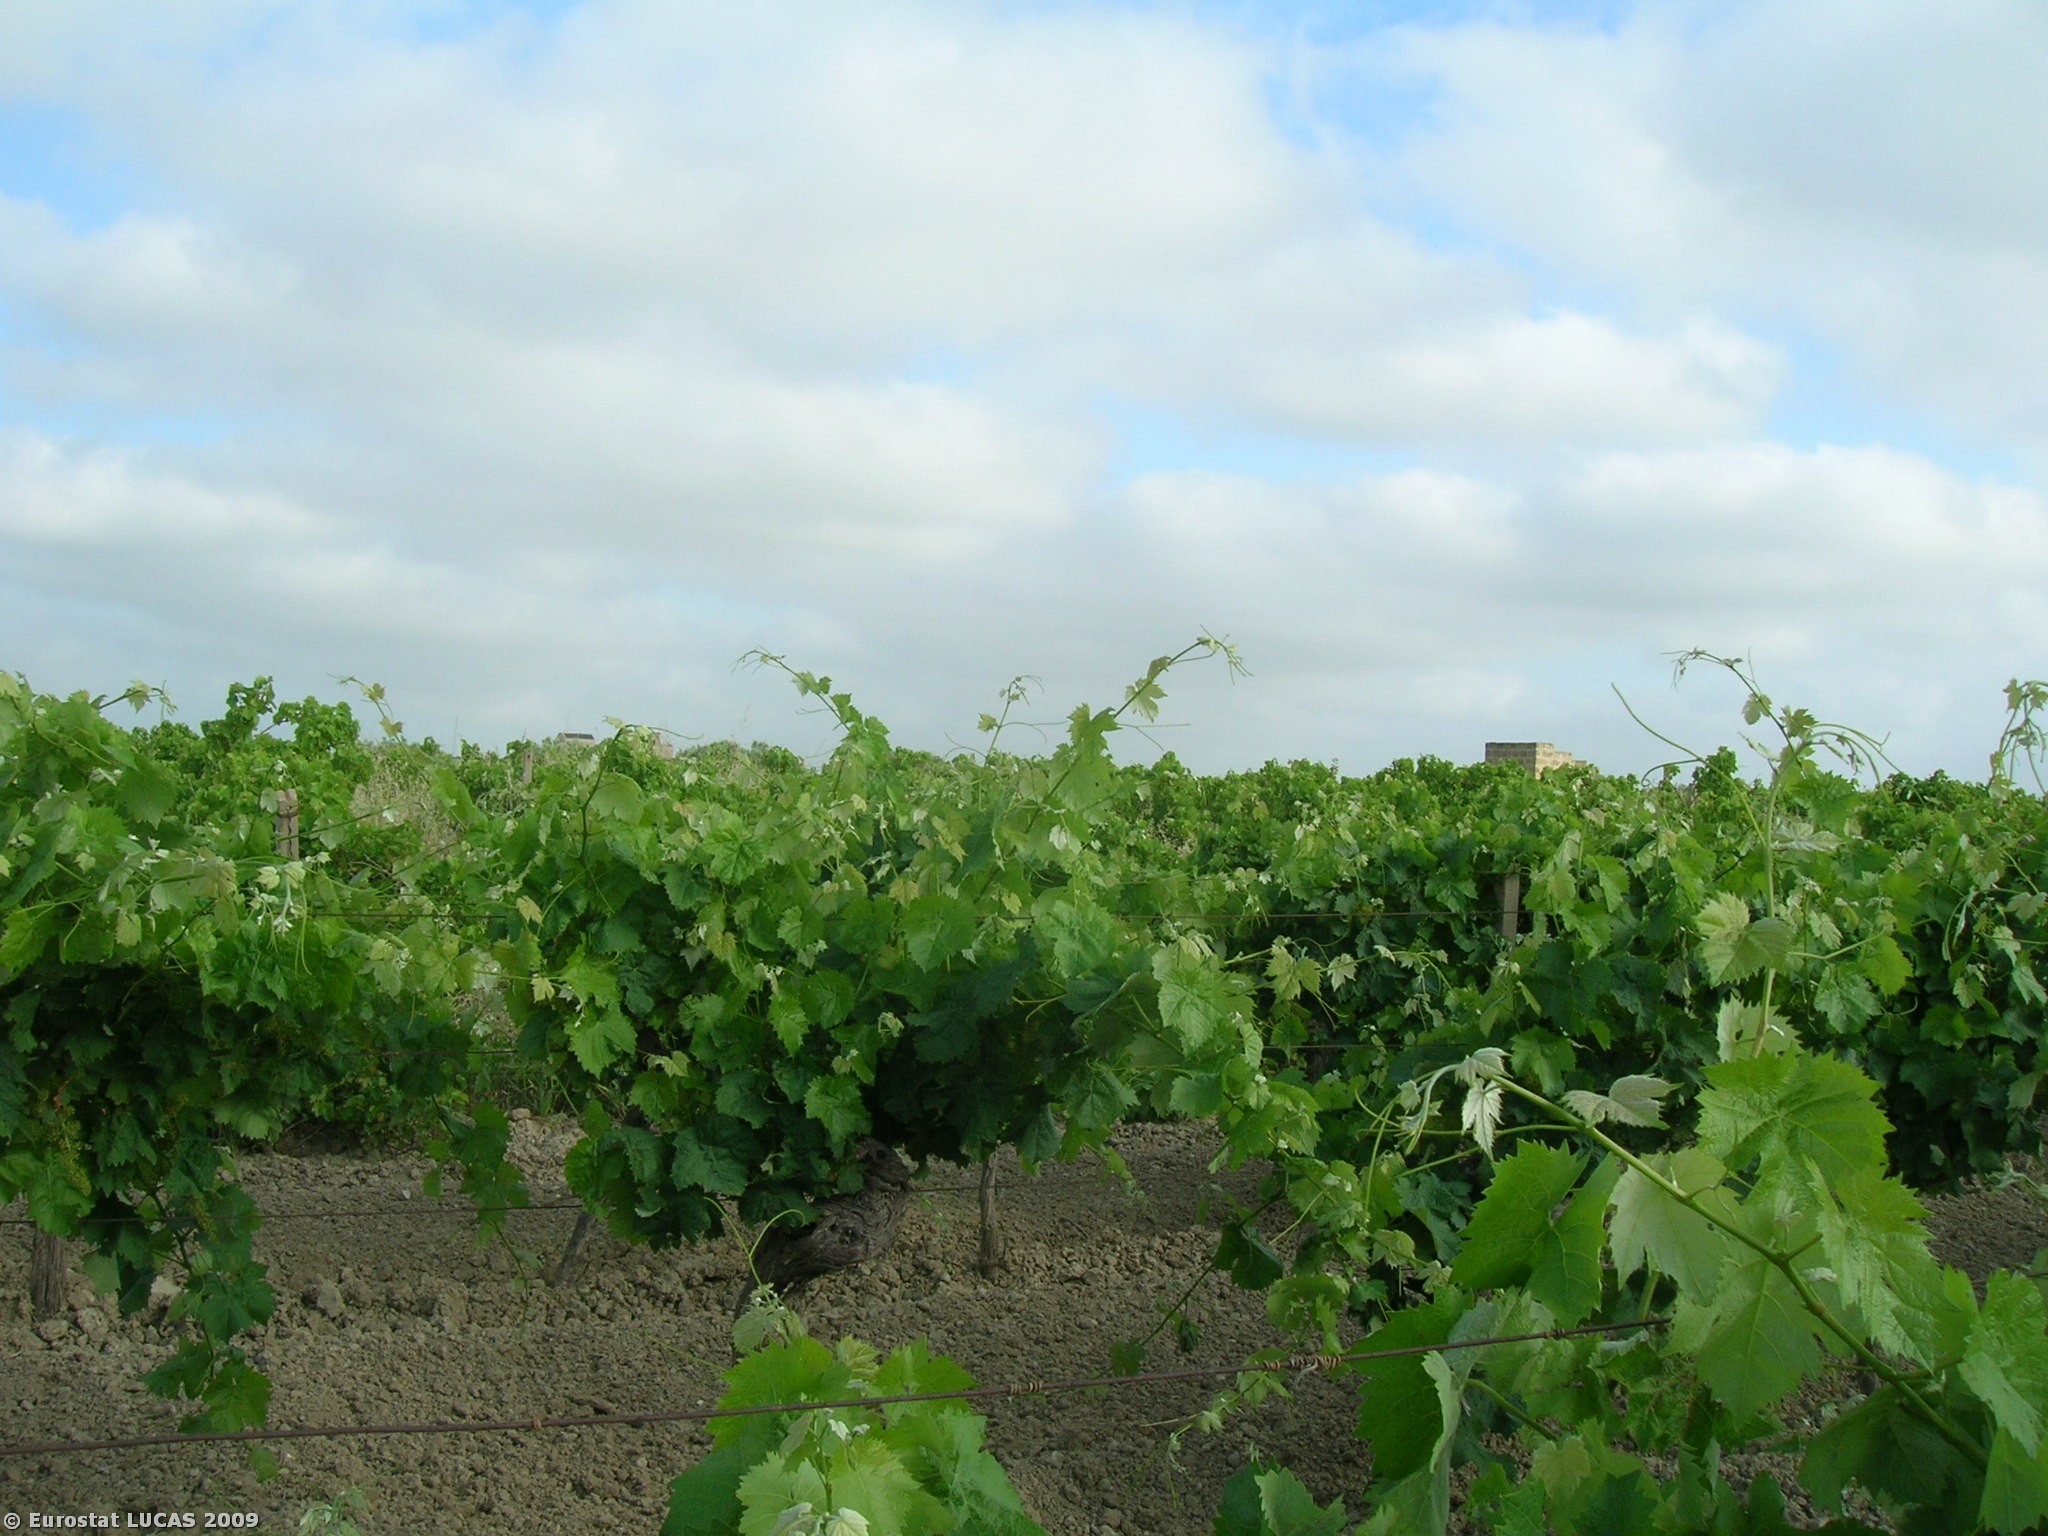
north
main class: Cropland
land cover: Vineyards
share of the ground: 50 - 75 %
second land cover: Bare land
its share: > 75 %
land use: Agriculture (excluding fallow land and kitchen gardens)
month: May
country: IT
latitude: 37.7477
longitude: 12.6246
